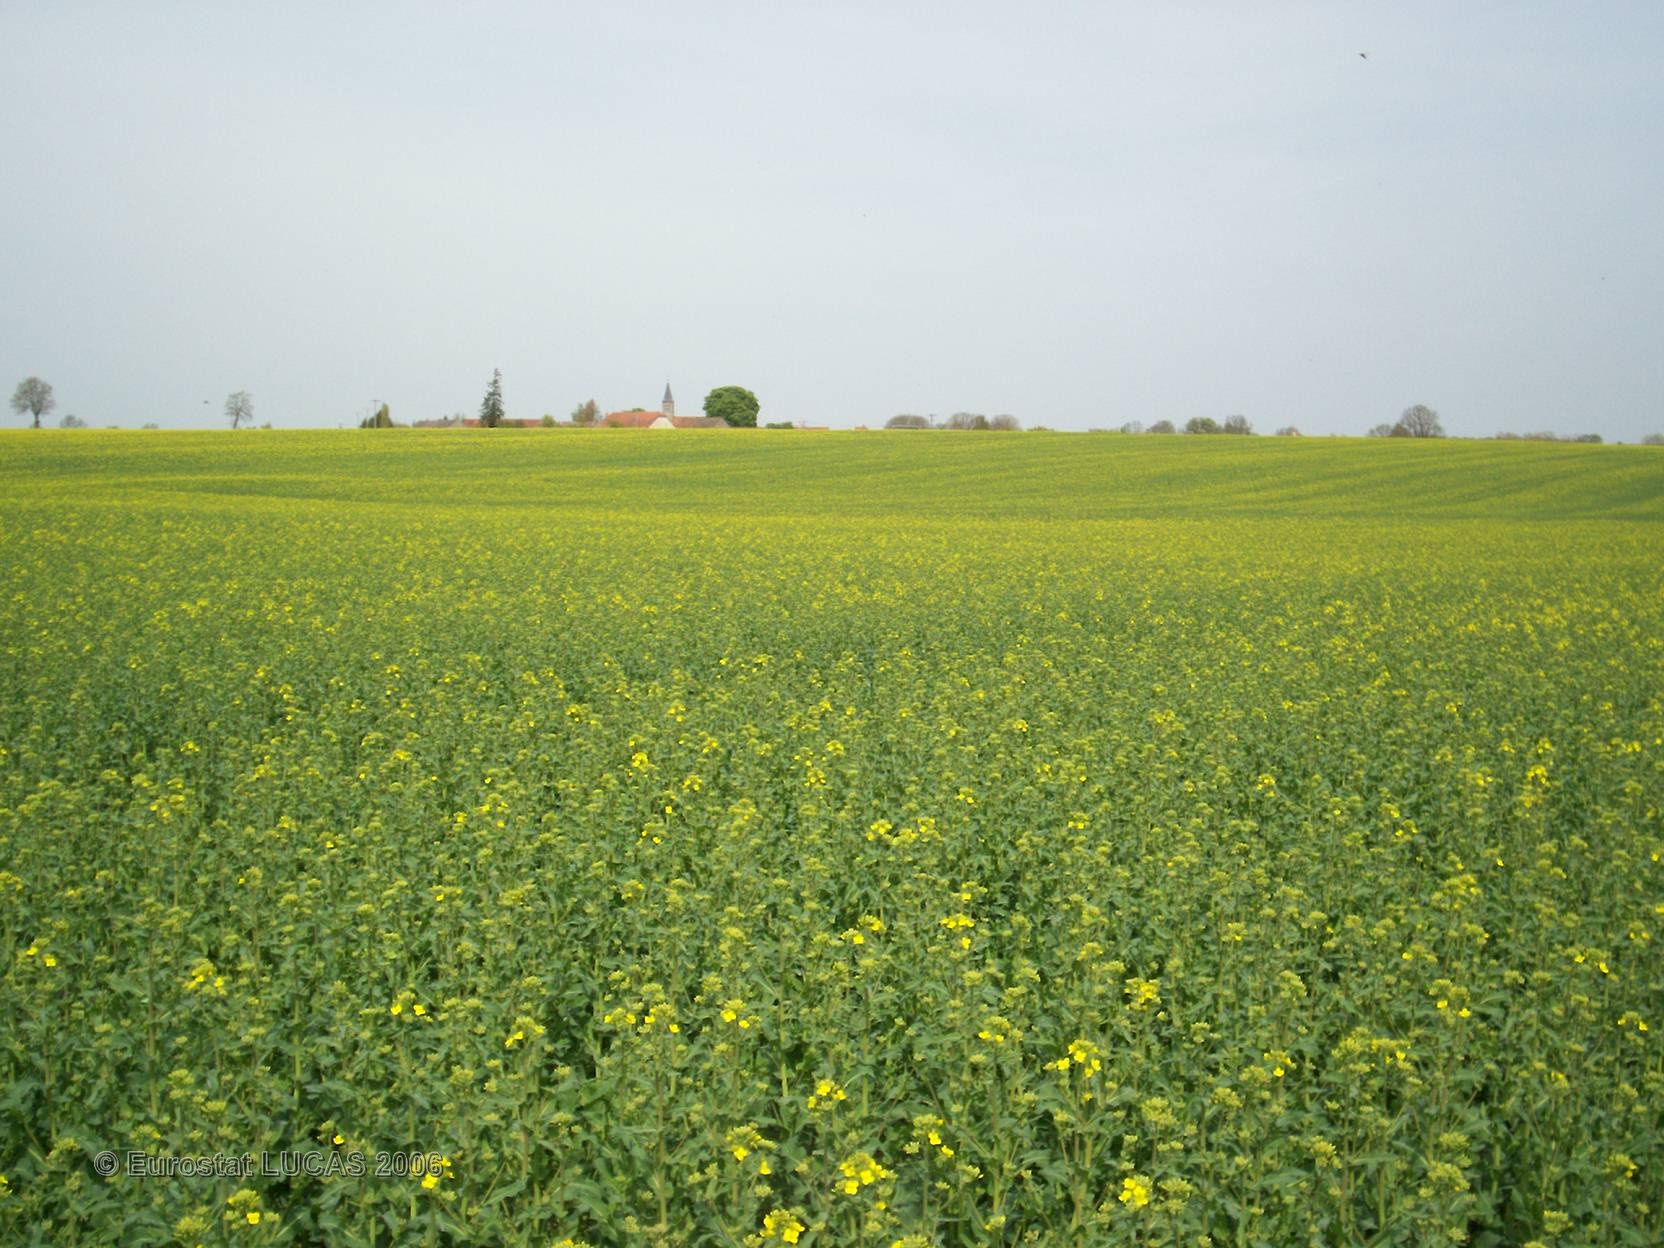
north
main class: Cropland
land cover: Rape and turnip rape
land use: Agriculture (excluding fallow land and kitchen gardens)
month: May
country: FR
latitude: 47.6215
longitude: 4.5835
